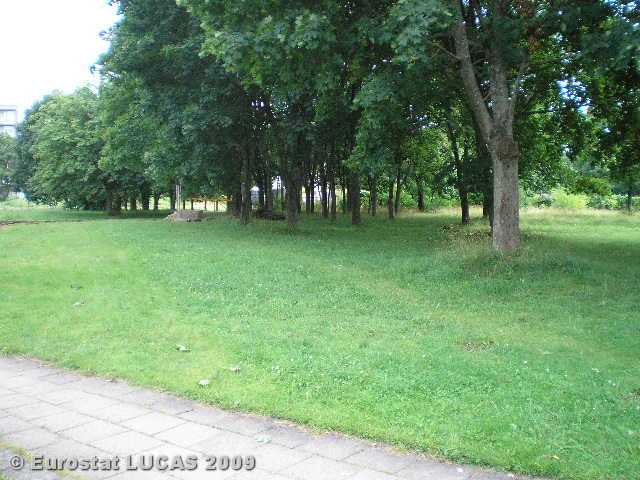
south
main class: Grassland
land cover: Grassland without tree/shrub cover
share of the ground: > 75 %
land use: Residential
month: July
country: LT
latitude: 54.7099
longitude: 25.3173
